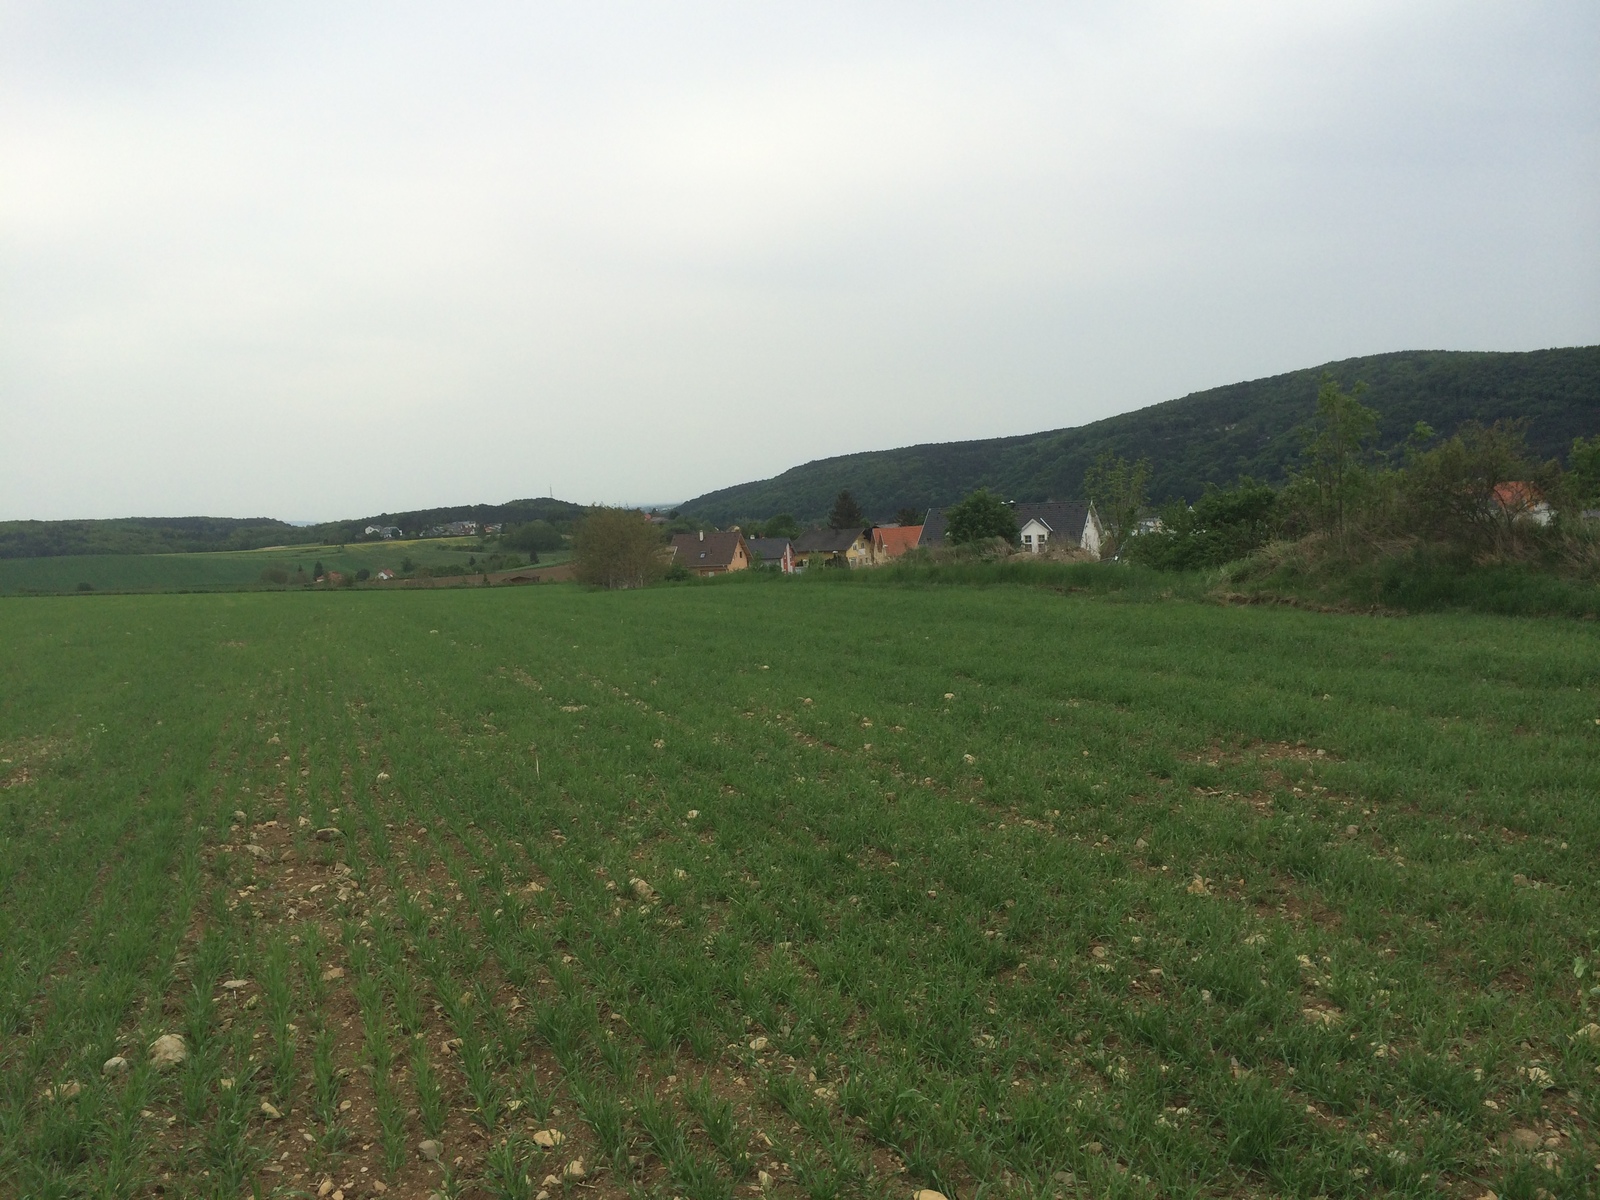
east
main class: Cropland
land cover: Barley
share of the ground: > 75 %
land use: Agriculture (excluding fallow land and kitchen gardens)
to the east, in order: Barley; Abandoned hedges; Rye; Grass margins; Tracks; Grassland without tree/shrub cover; Barley
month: May
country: AT
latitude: 47.9436
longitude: 16.1488
